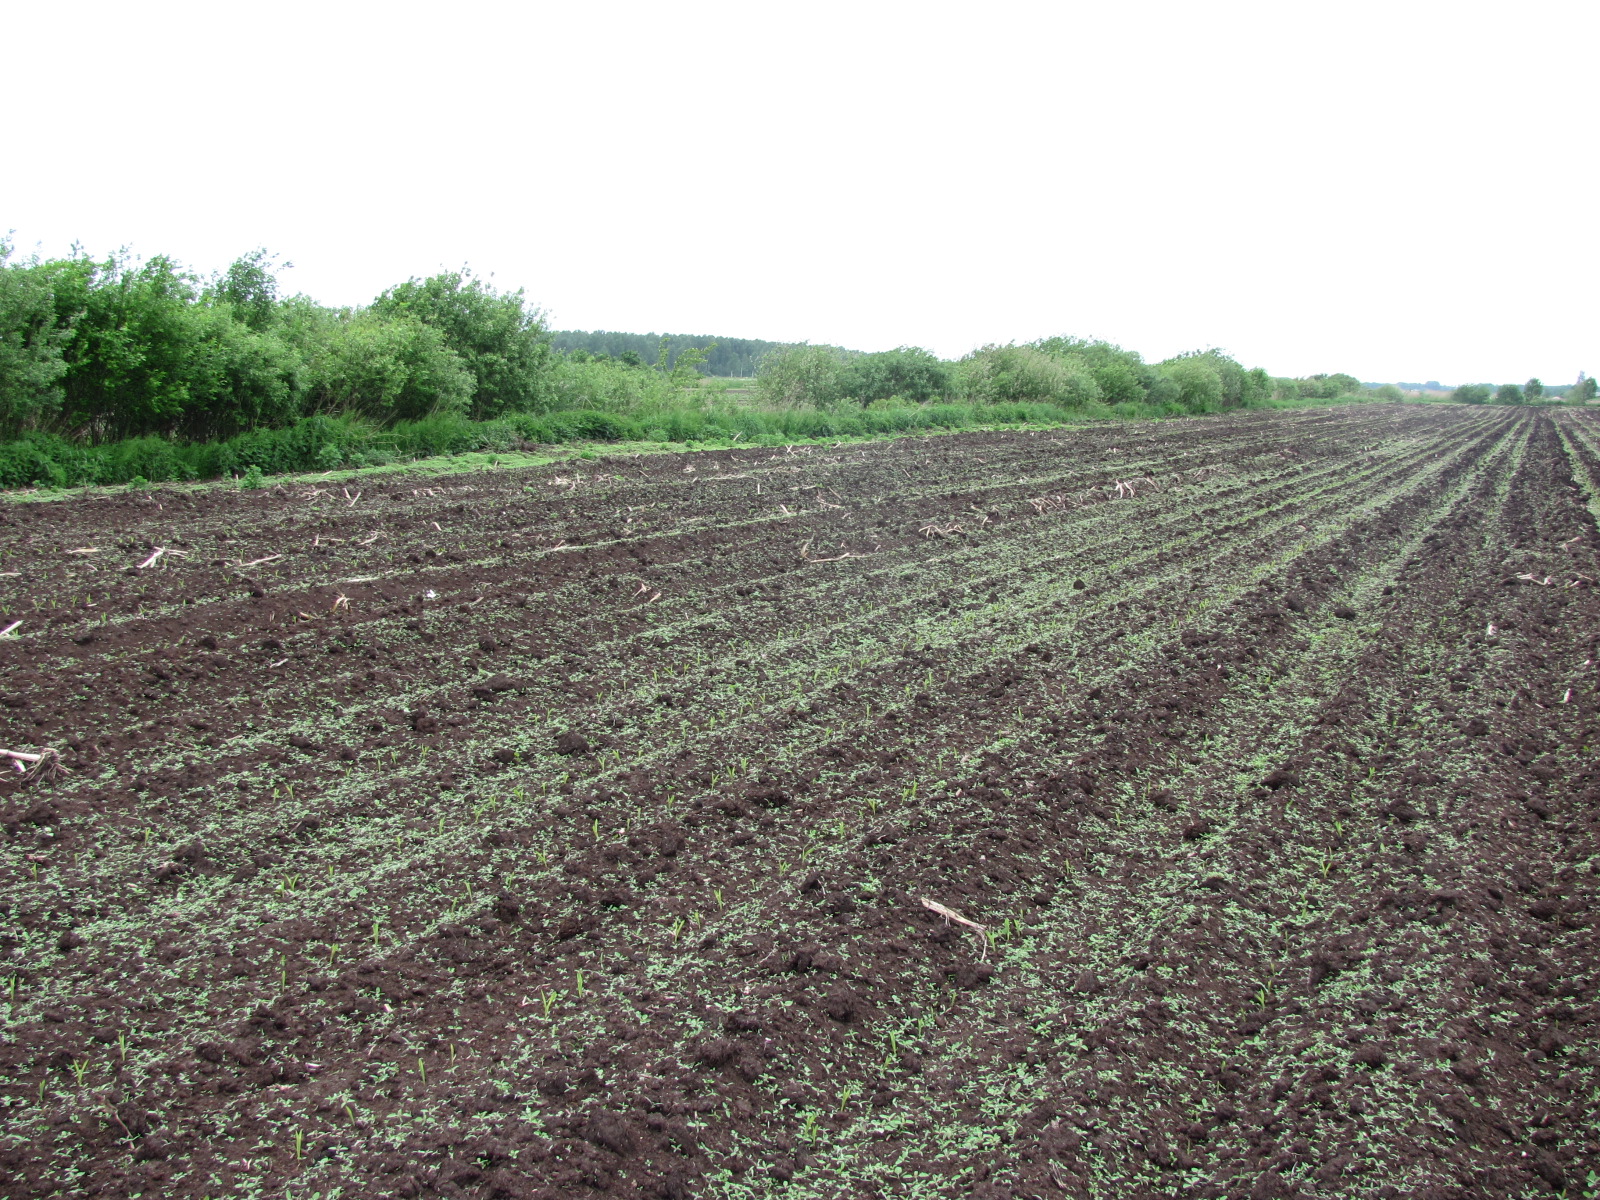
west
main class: Cropland
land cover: Maize
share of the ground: < 10 %
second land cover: Spontaneously vegetated surfaces
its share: 25 - 50 %
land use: Agriculture (excluding fallow land and kitchen gardens)
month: June
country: LV
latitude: 56.8587
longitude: 24.0077
